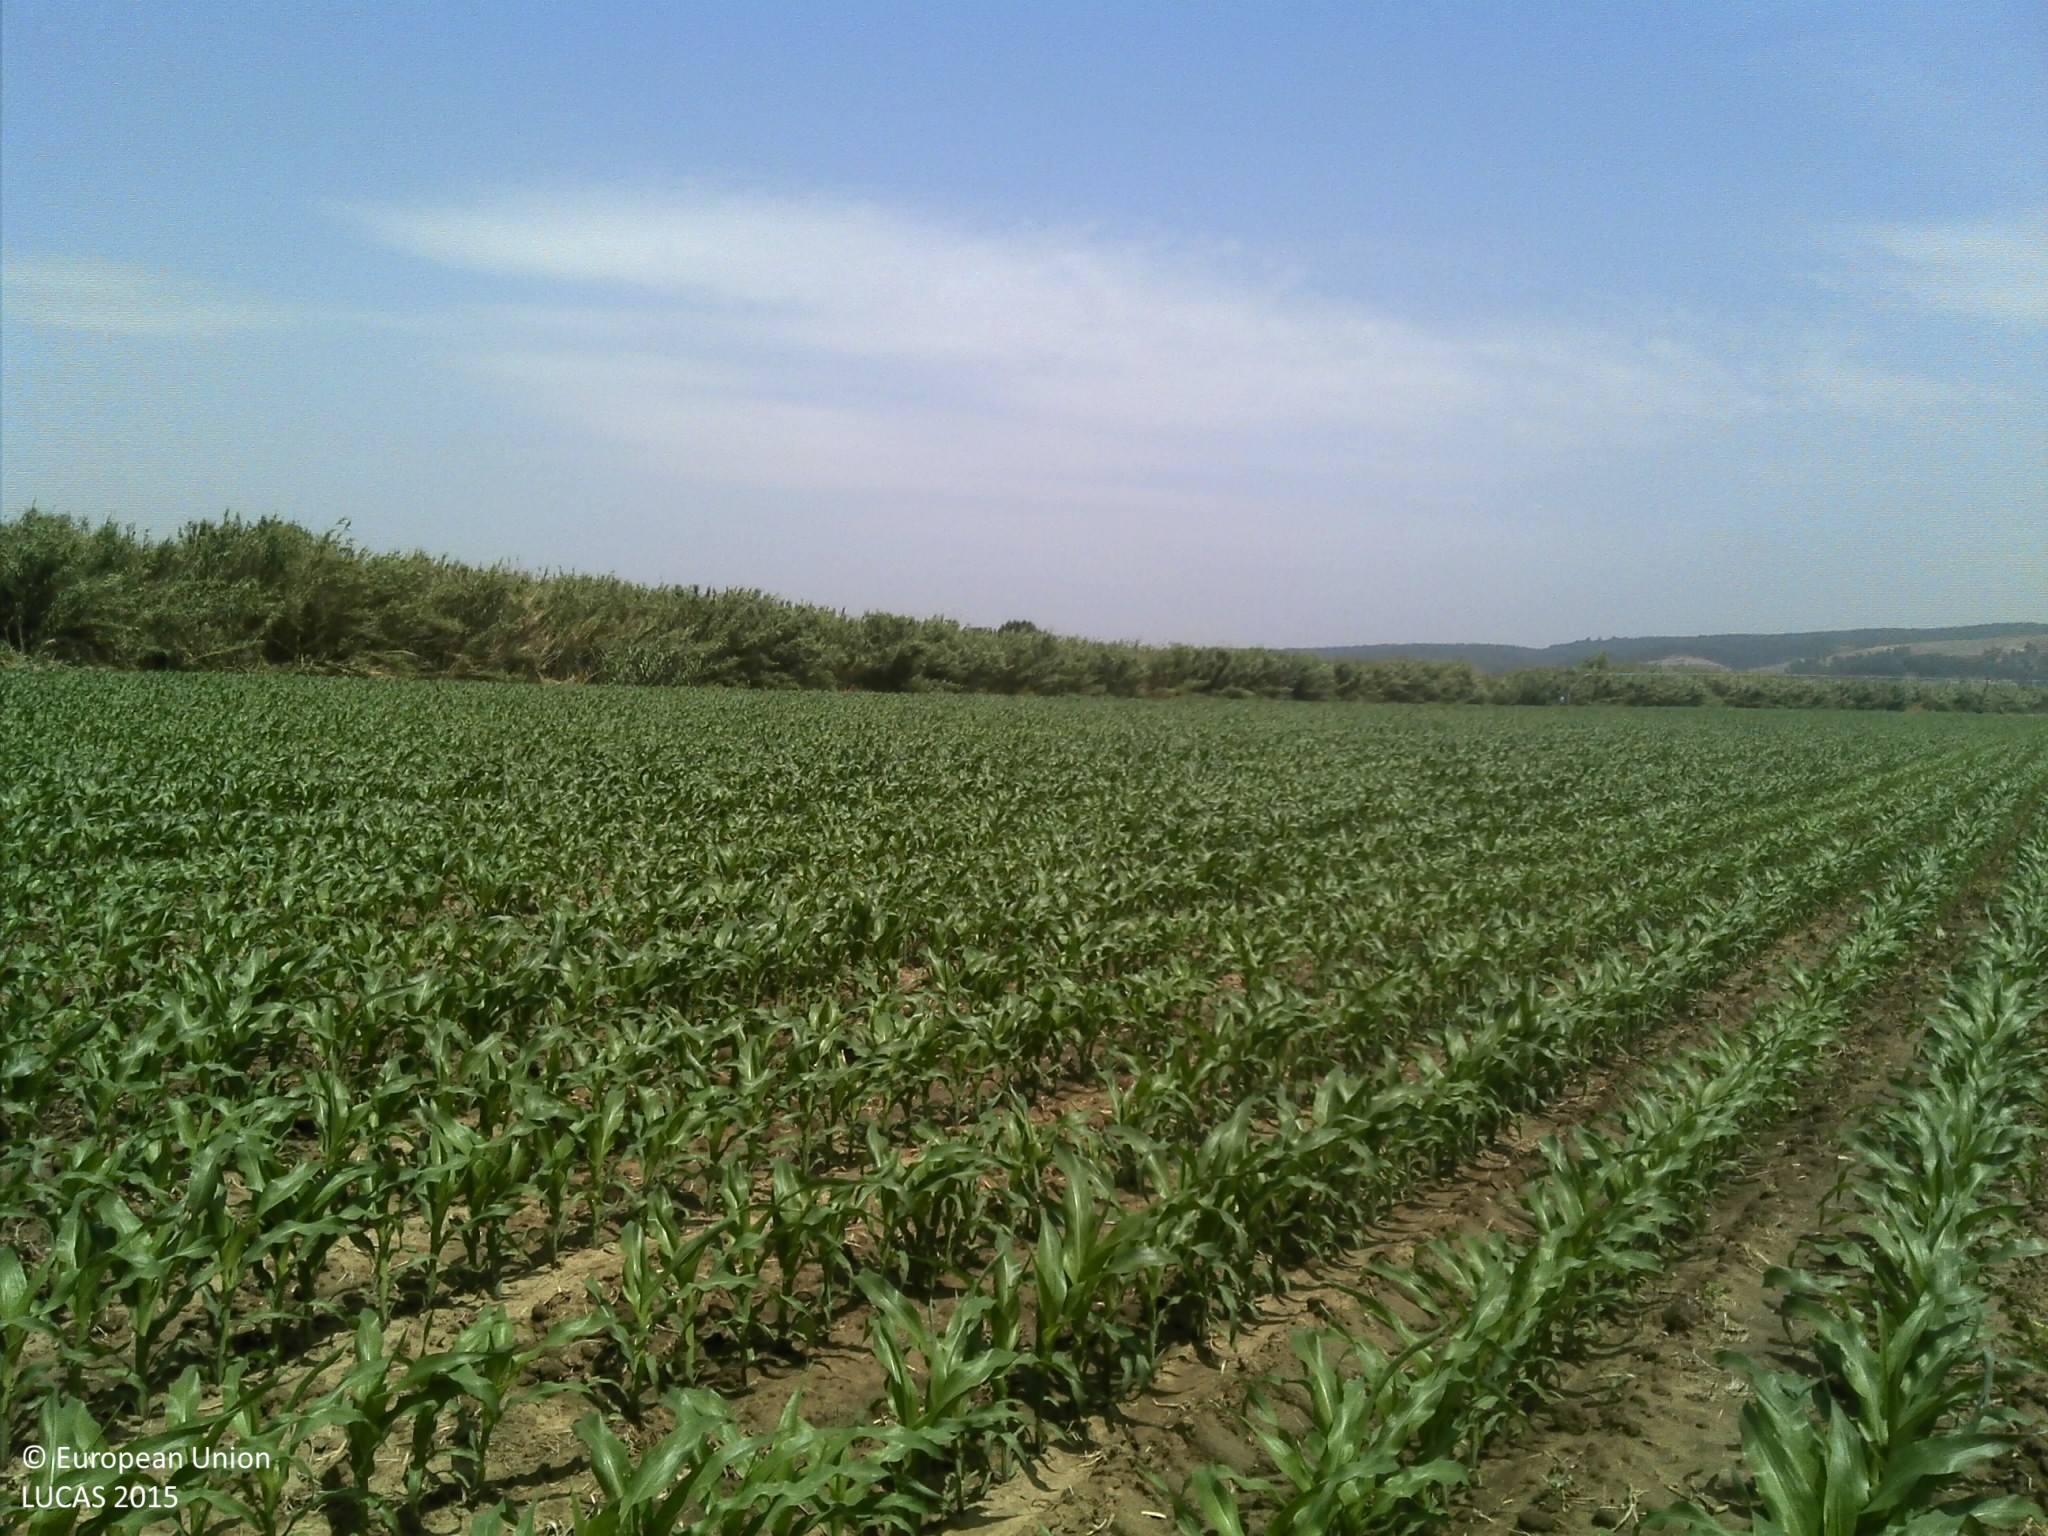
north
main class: Cropland
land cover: Maize
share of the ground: 10 - 25 %
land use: Agriculture (excluding fallow land and kitchen gardens)
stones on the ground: < 10 %
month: June
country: PT
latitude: 39.4456
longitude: -8.4410
